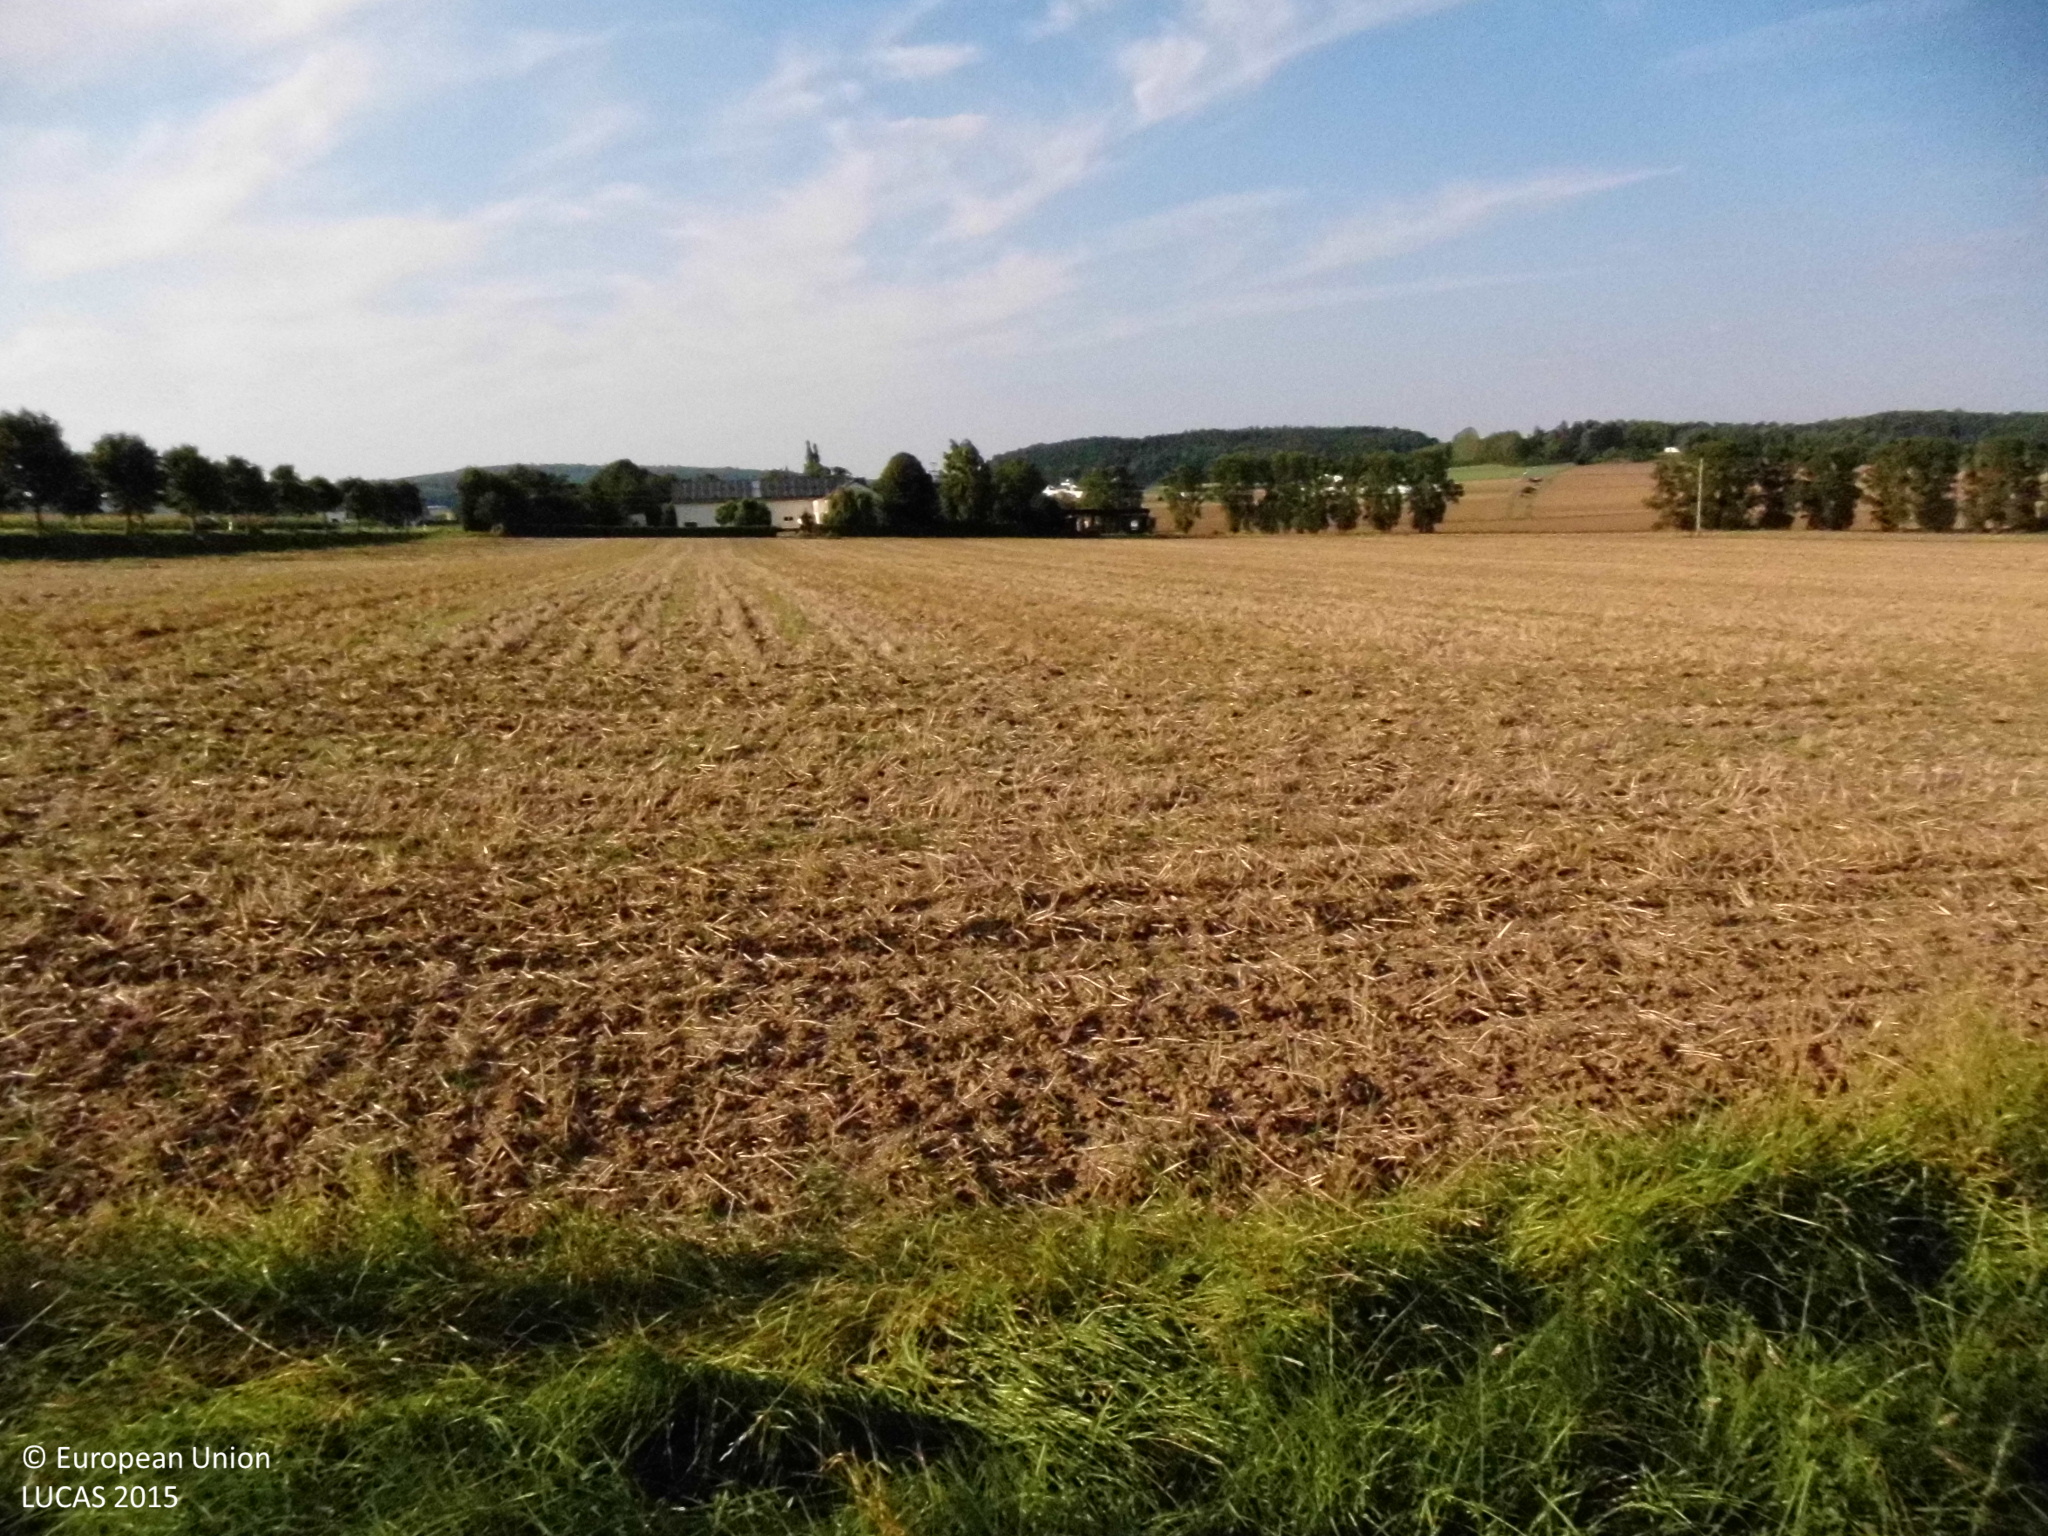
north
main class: Grassland
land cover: Grassland without tree/shrub cover
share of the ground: > 75 %
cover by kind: herbaceous plants 100 %
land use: Agriculture (excluding fallow land and kitchen gardens)
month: August
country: DE
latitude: 50.4921
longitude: 8.0974
